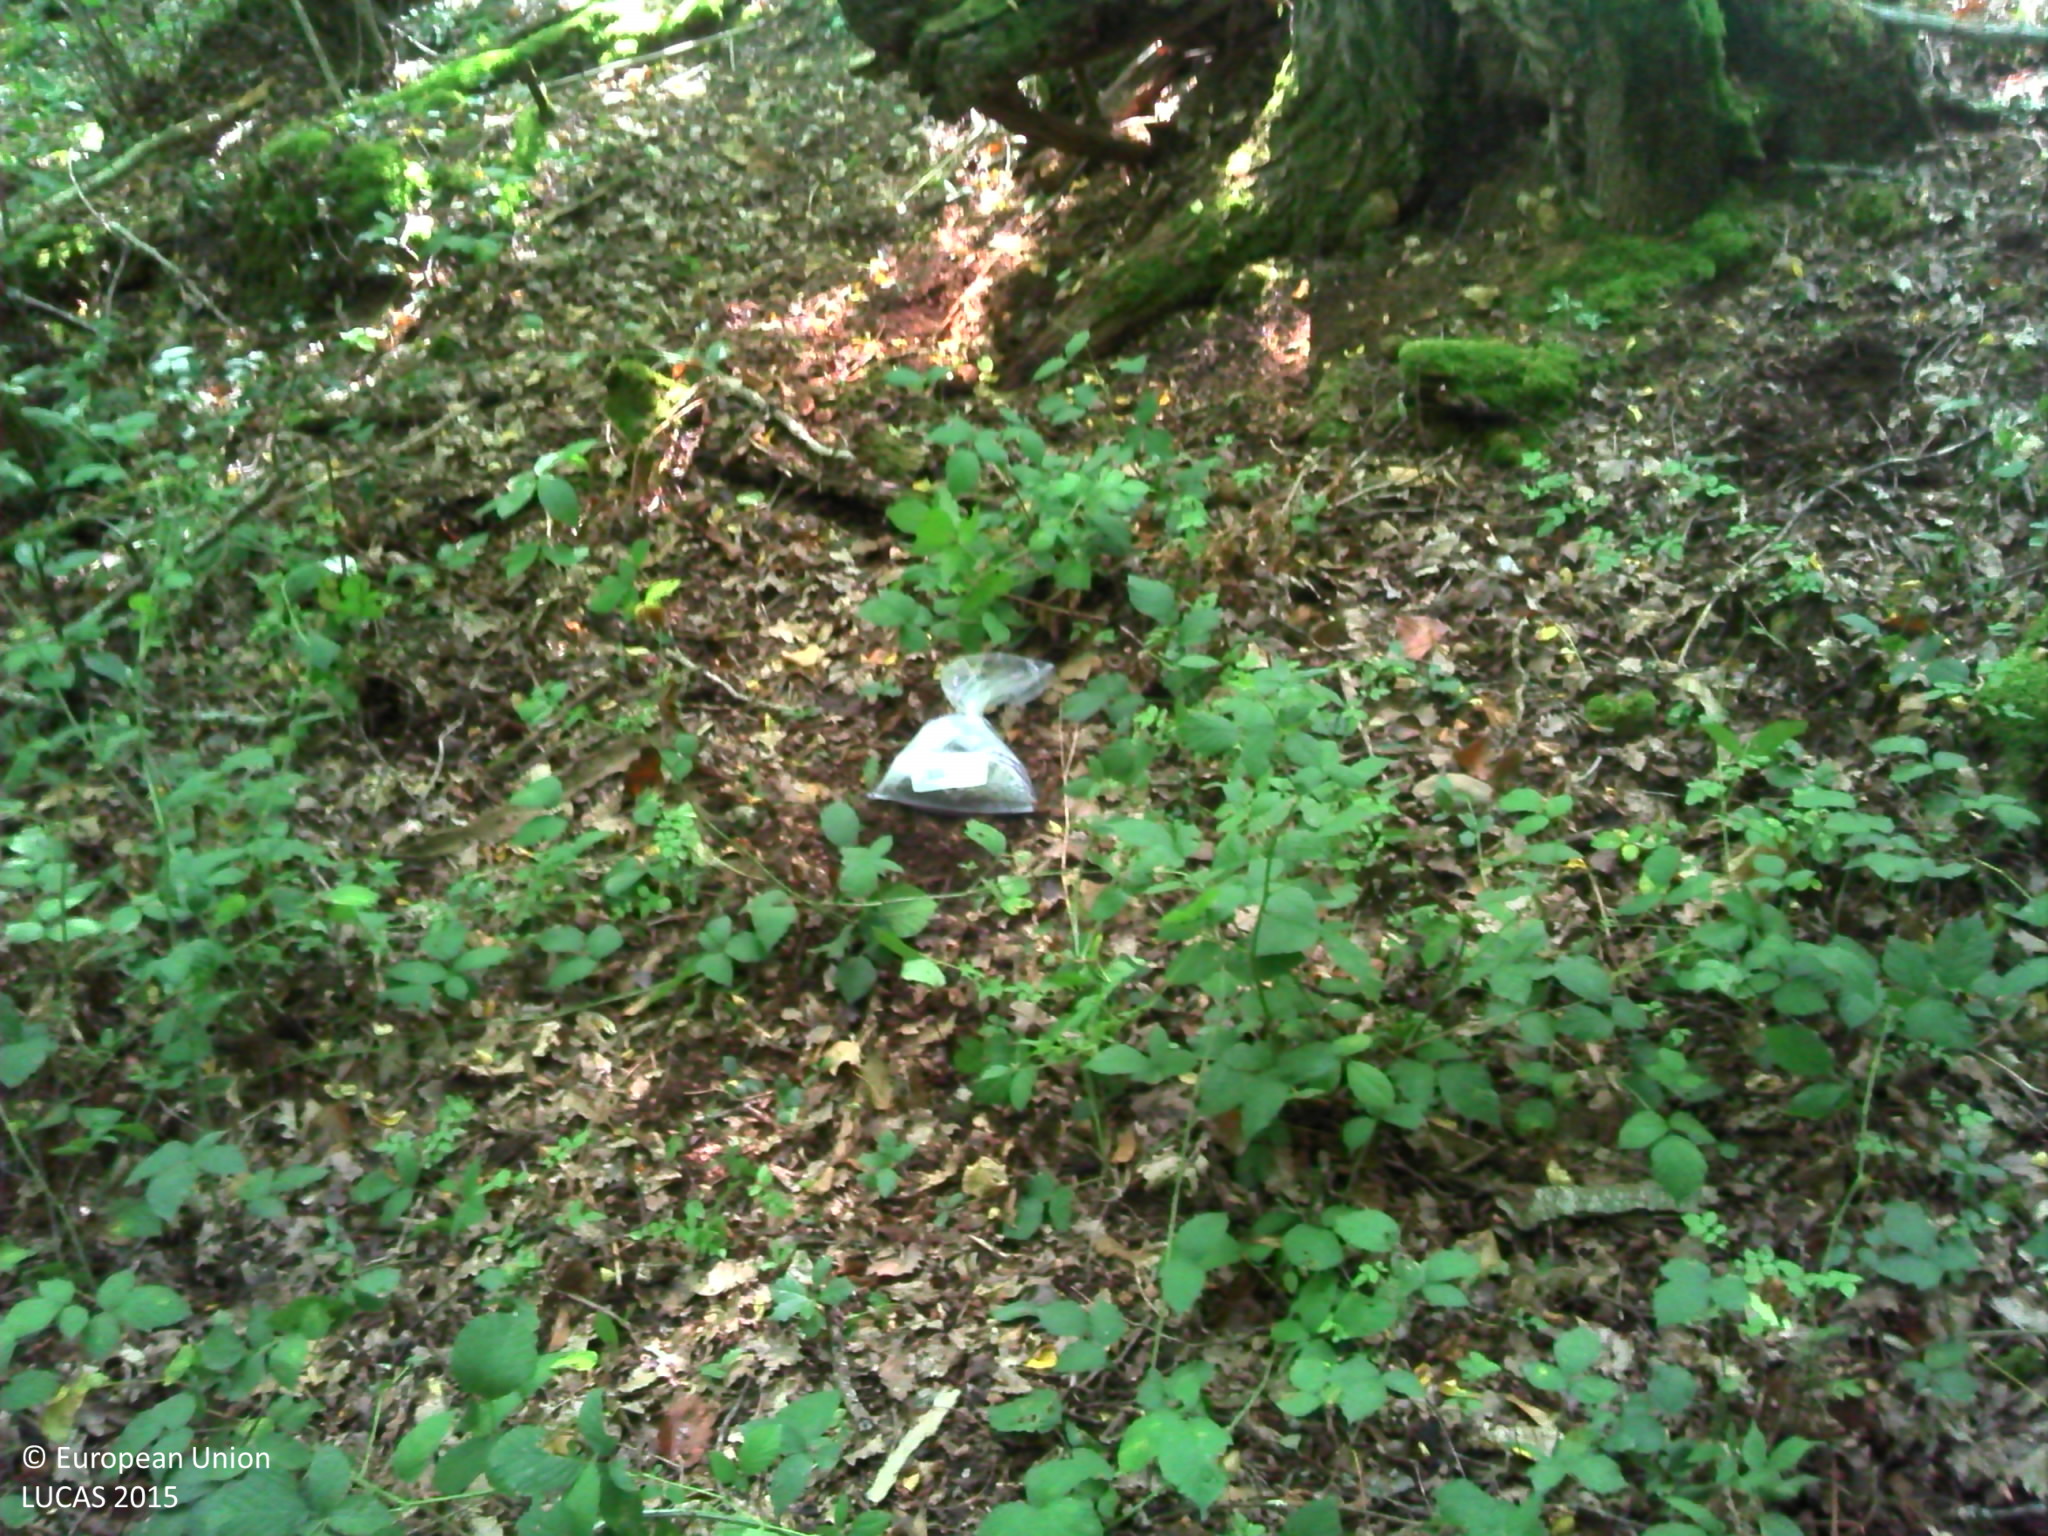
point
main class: Woodland
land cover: Broadleaved woodland
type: mesophytic deciduous forest
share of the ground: > 75 %
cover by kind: broadleaved forest trees 70 %, herbaceous plants 15 %, shrubs 10 %
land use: Forestry
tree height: > 5 m
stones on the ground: < 10 %
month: August
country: FR
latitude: 45.2072
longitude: 0.7597
